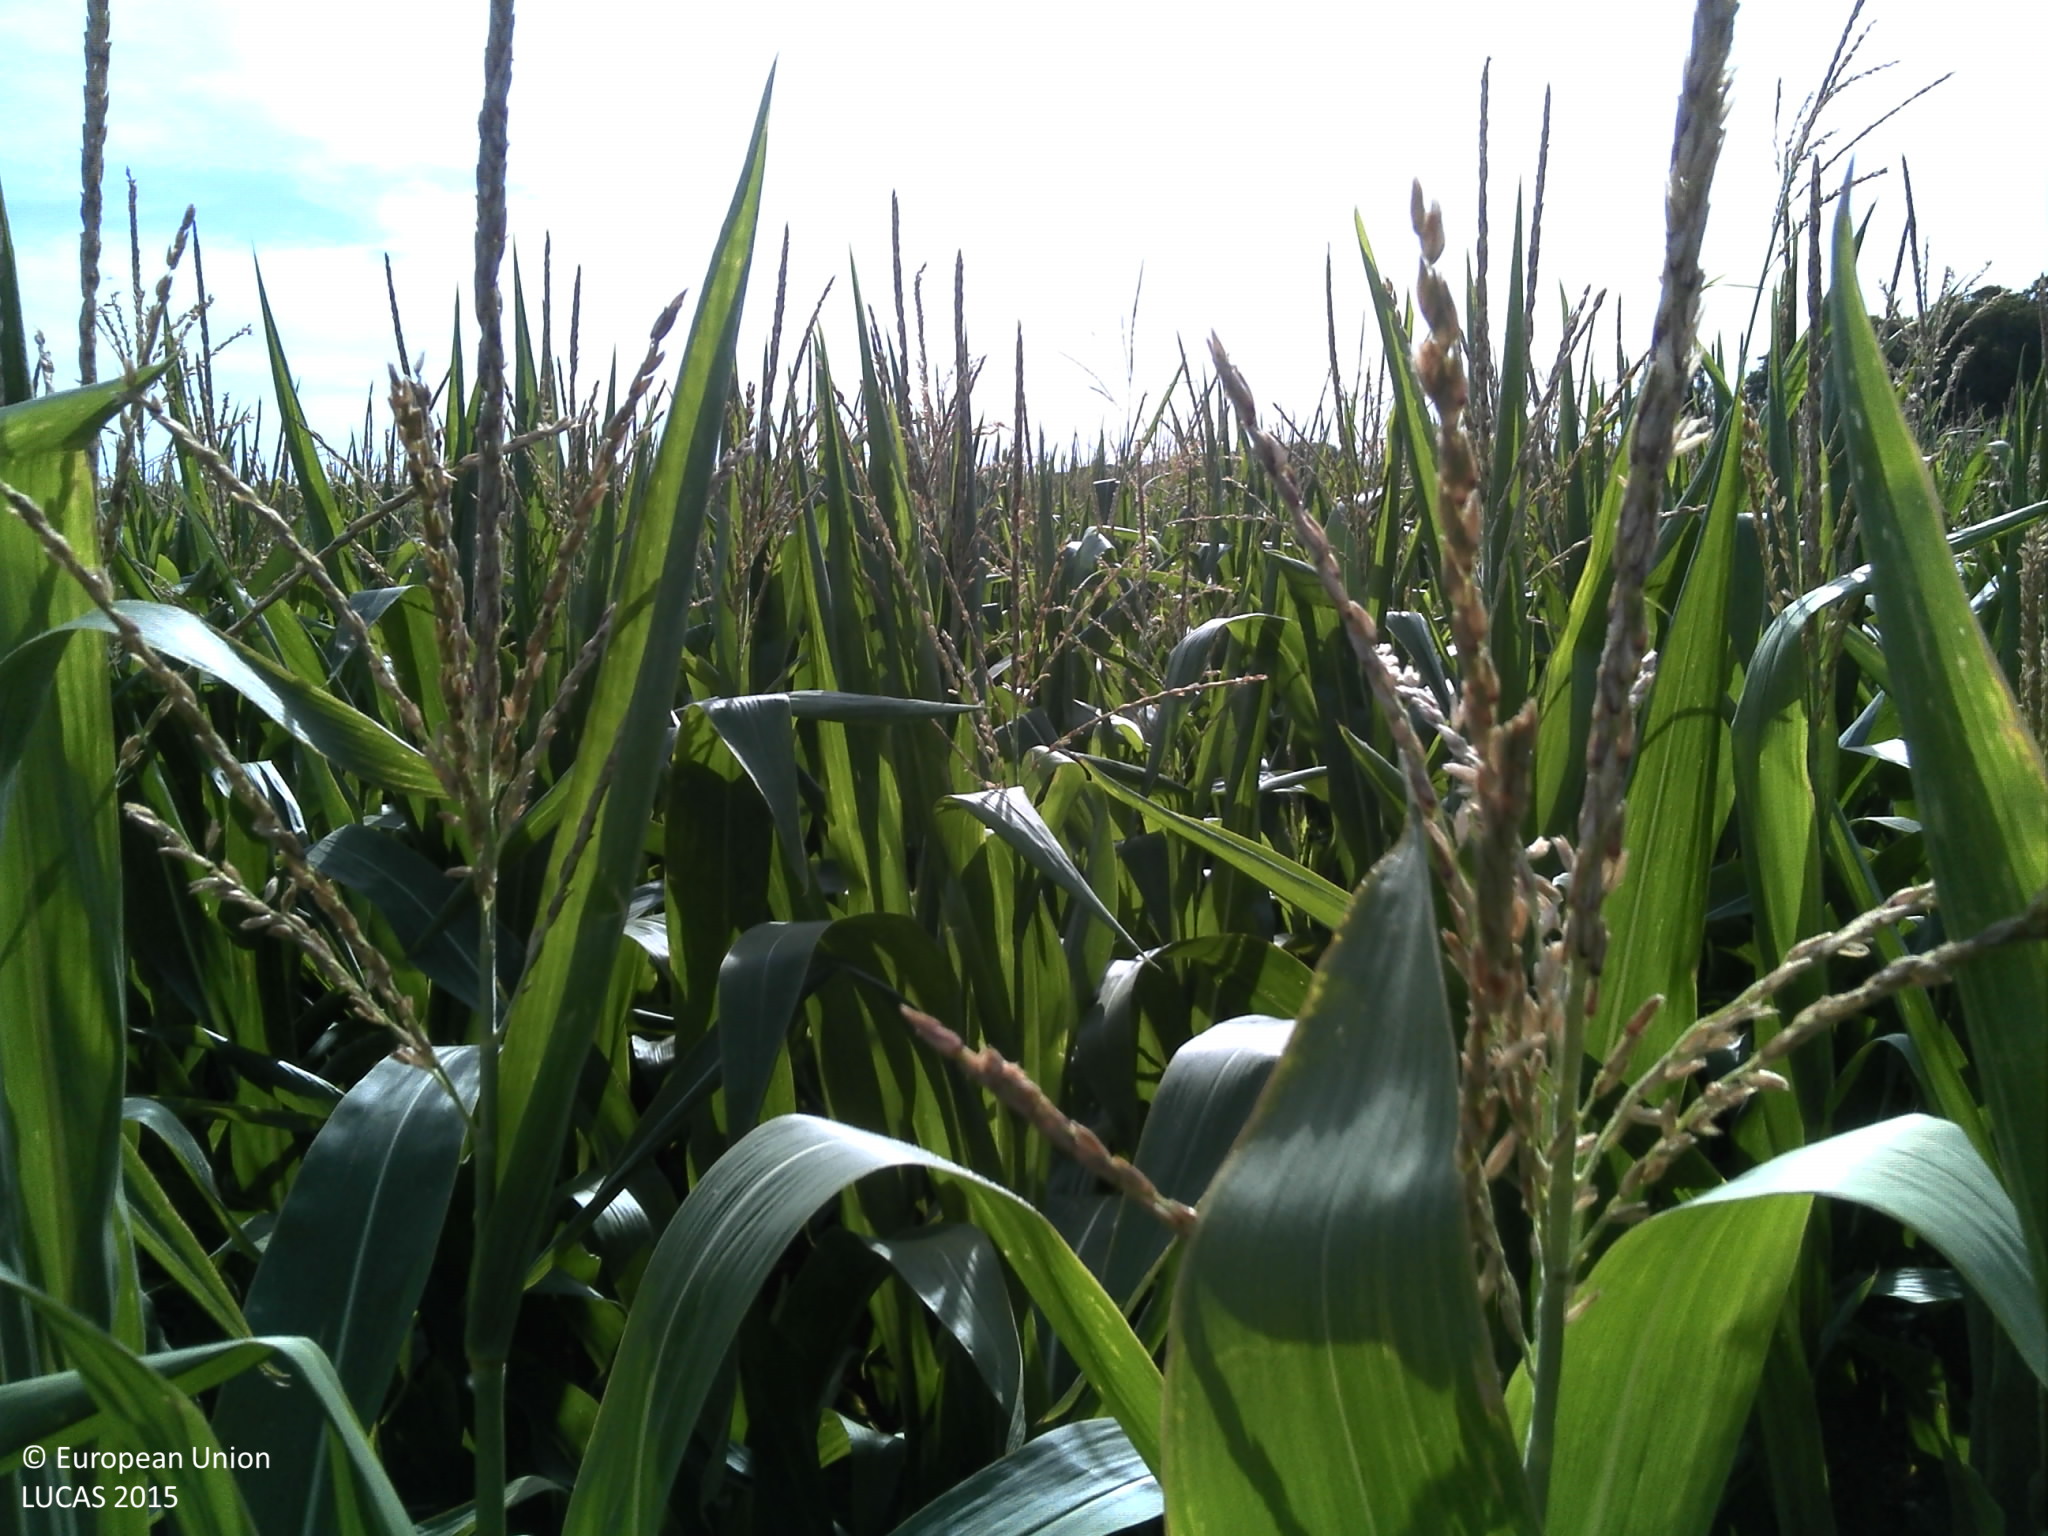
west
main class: Cropland
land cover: Maize
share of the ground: 25 - 50 %
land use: Agriculture (excluding fallow land and kitchen gardens)
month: August
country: FR
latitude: 48.9864
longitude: 4.8458
